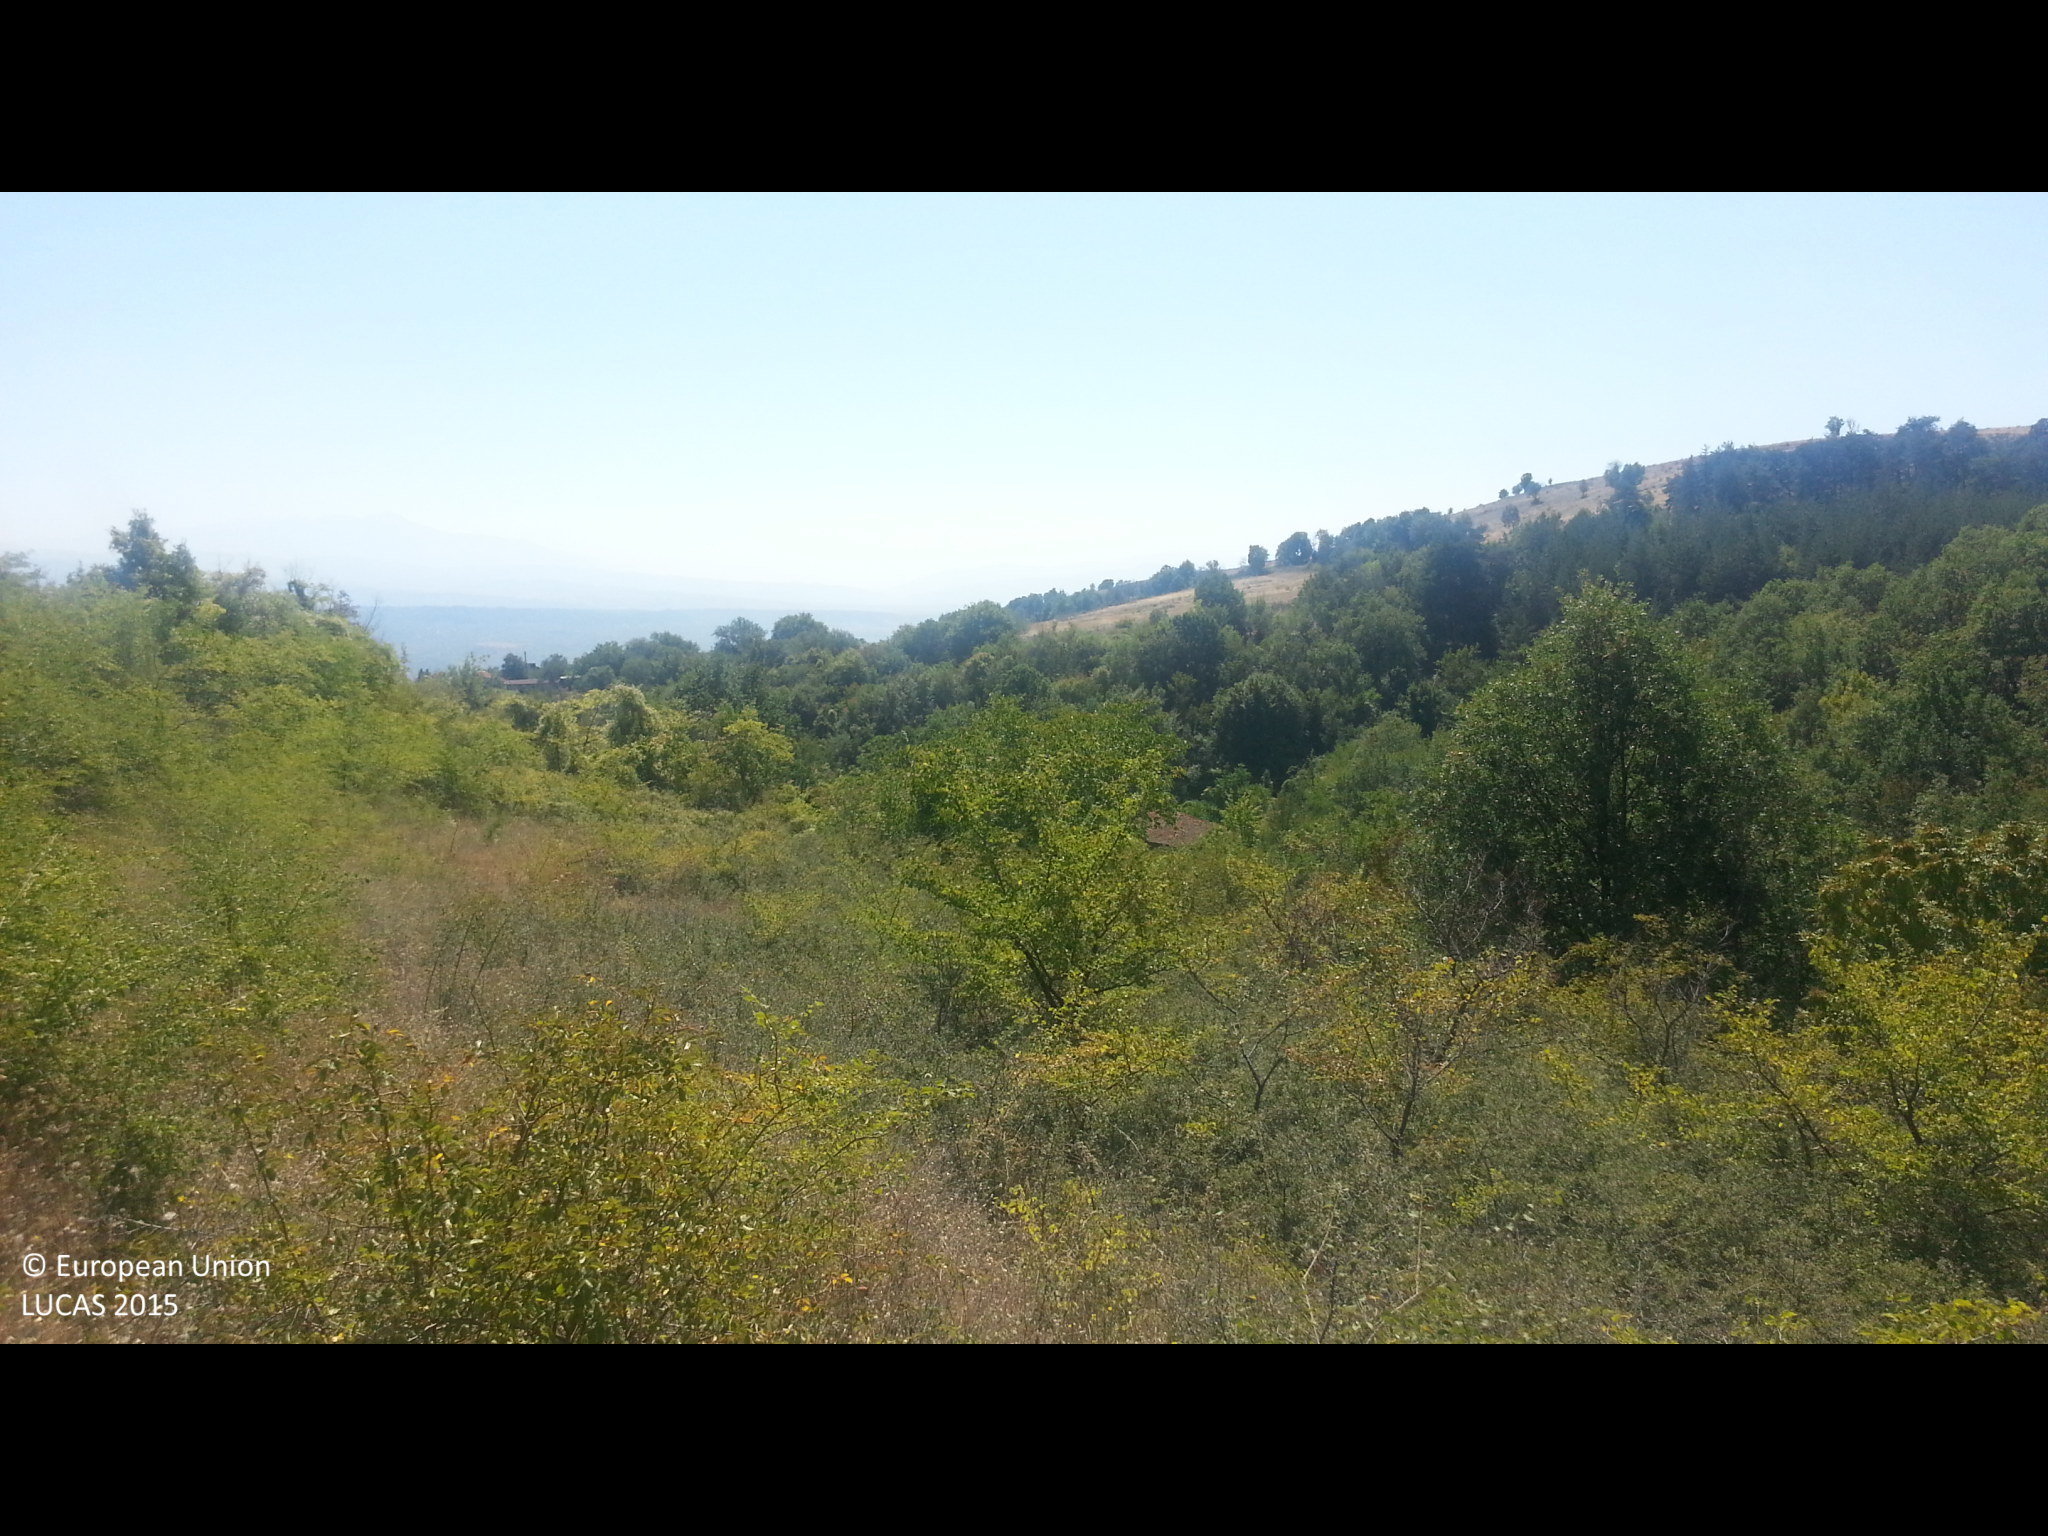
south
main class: Shrubland
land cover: Shrubland without tree cover
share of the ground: 50 - 75 %
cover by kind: shrubs 70 %, herbaceous plants 30 %
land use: Semi-natural and natural areas not in use
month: September
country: BG
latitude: 42.1935
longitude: 23.0186
